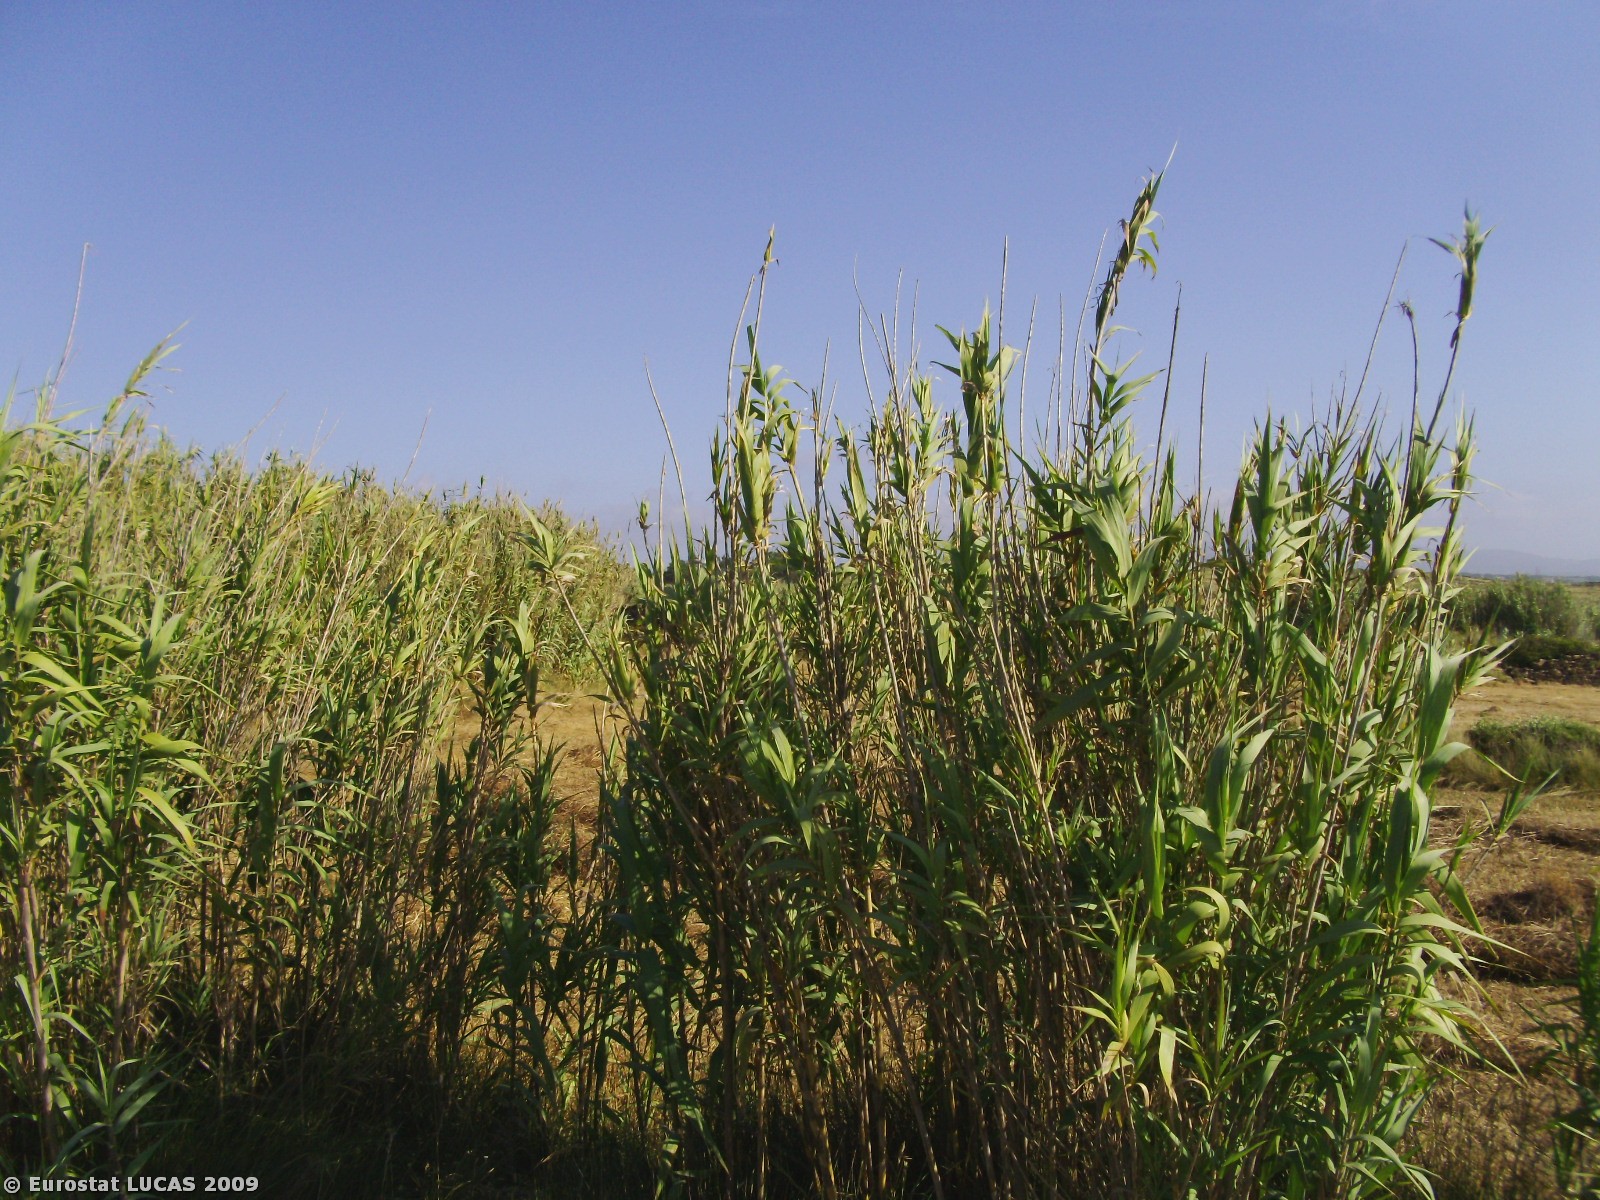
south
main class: Grassland
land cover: Spontaneously vegetated surfaces
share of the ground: > 75 %
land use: Nature reserves
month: July
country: PT
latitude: 38.8764
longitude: -9.4405
